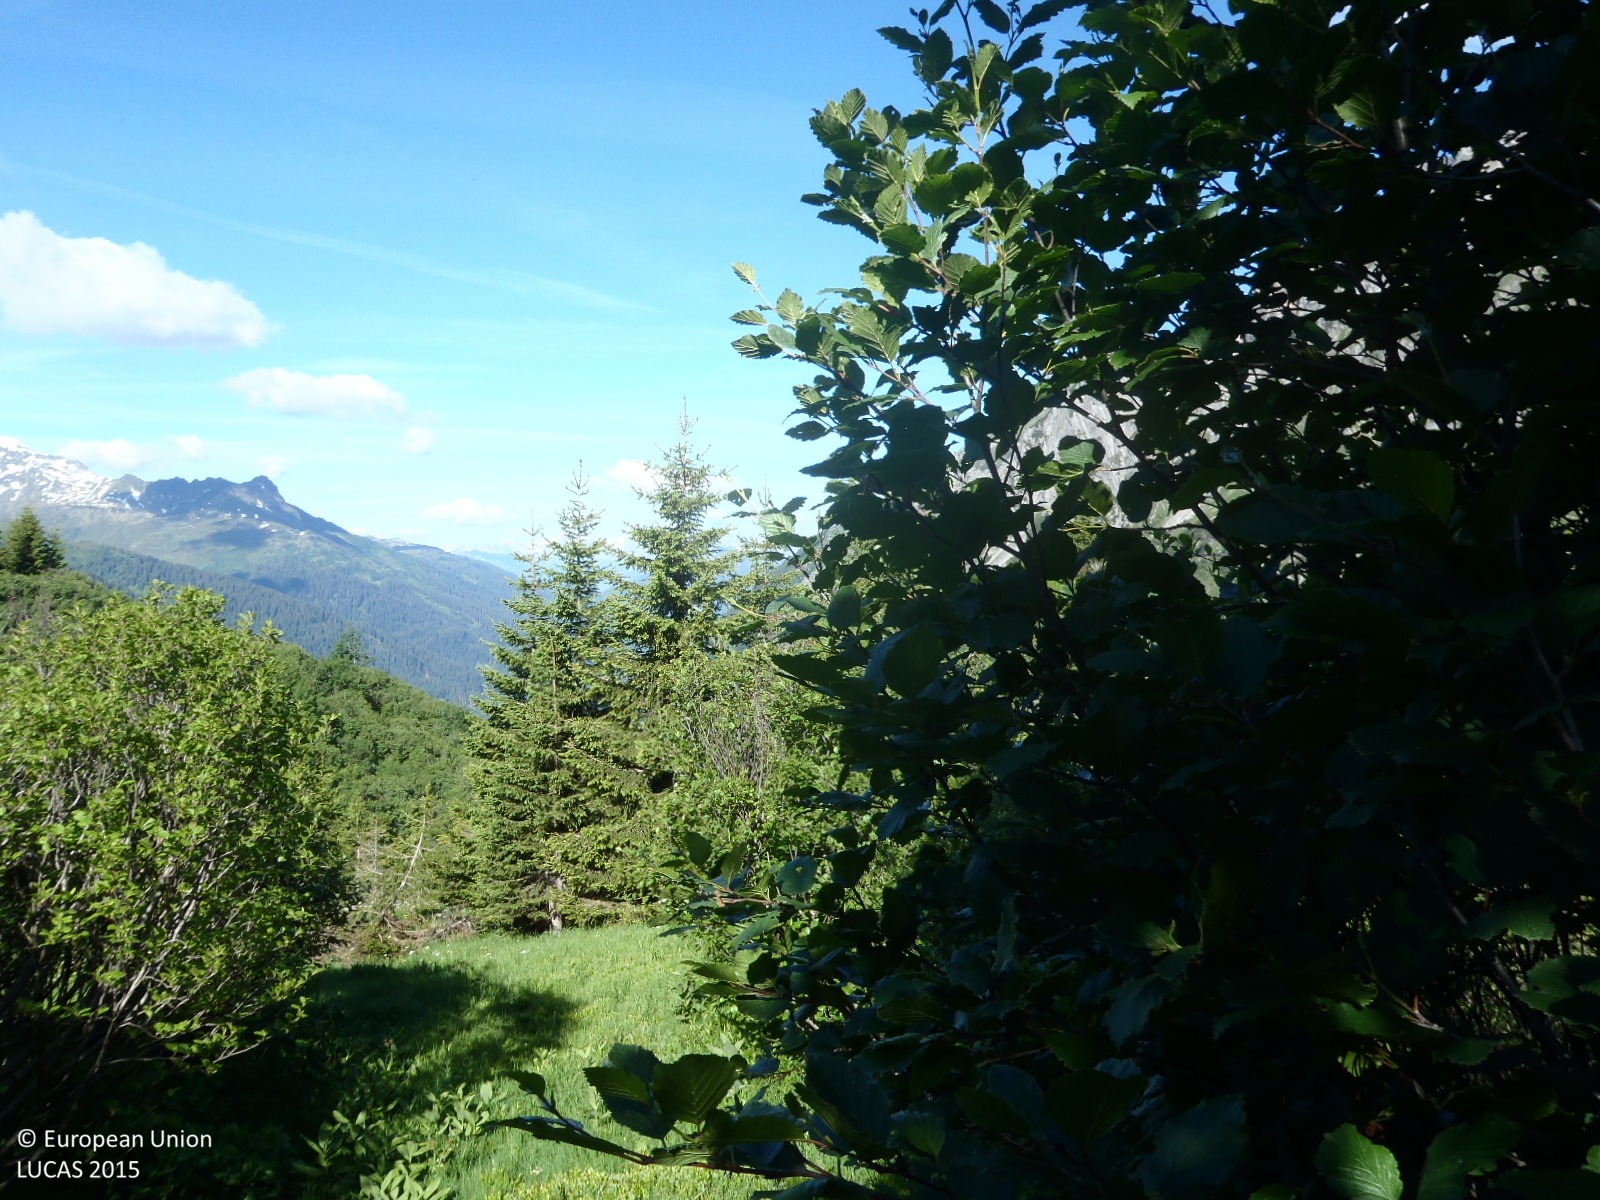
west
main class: Shrubland
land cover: Shrubland with sparse tree cover
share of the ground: > 75 %
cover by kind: shrubs 95 %, coniferous forest trees 5 %
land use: Agriculture (excluding fallow land and kitchen gardens)
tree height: > 5 m
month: June
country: AT
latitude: 47.1434
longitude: 10.1713
